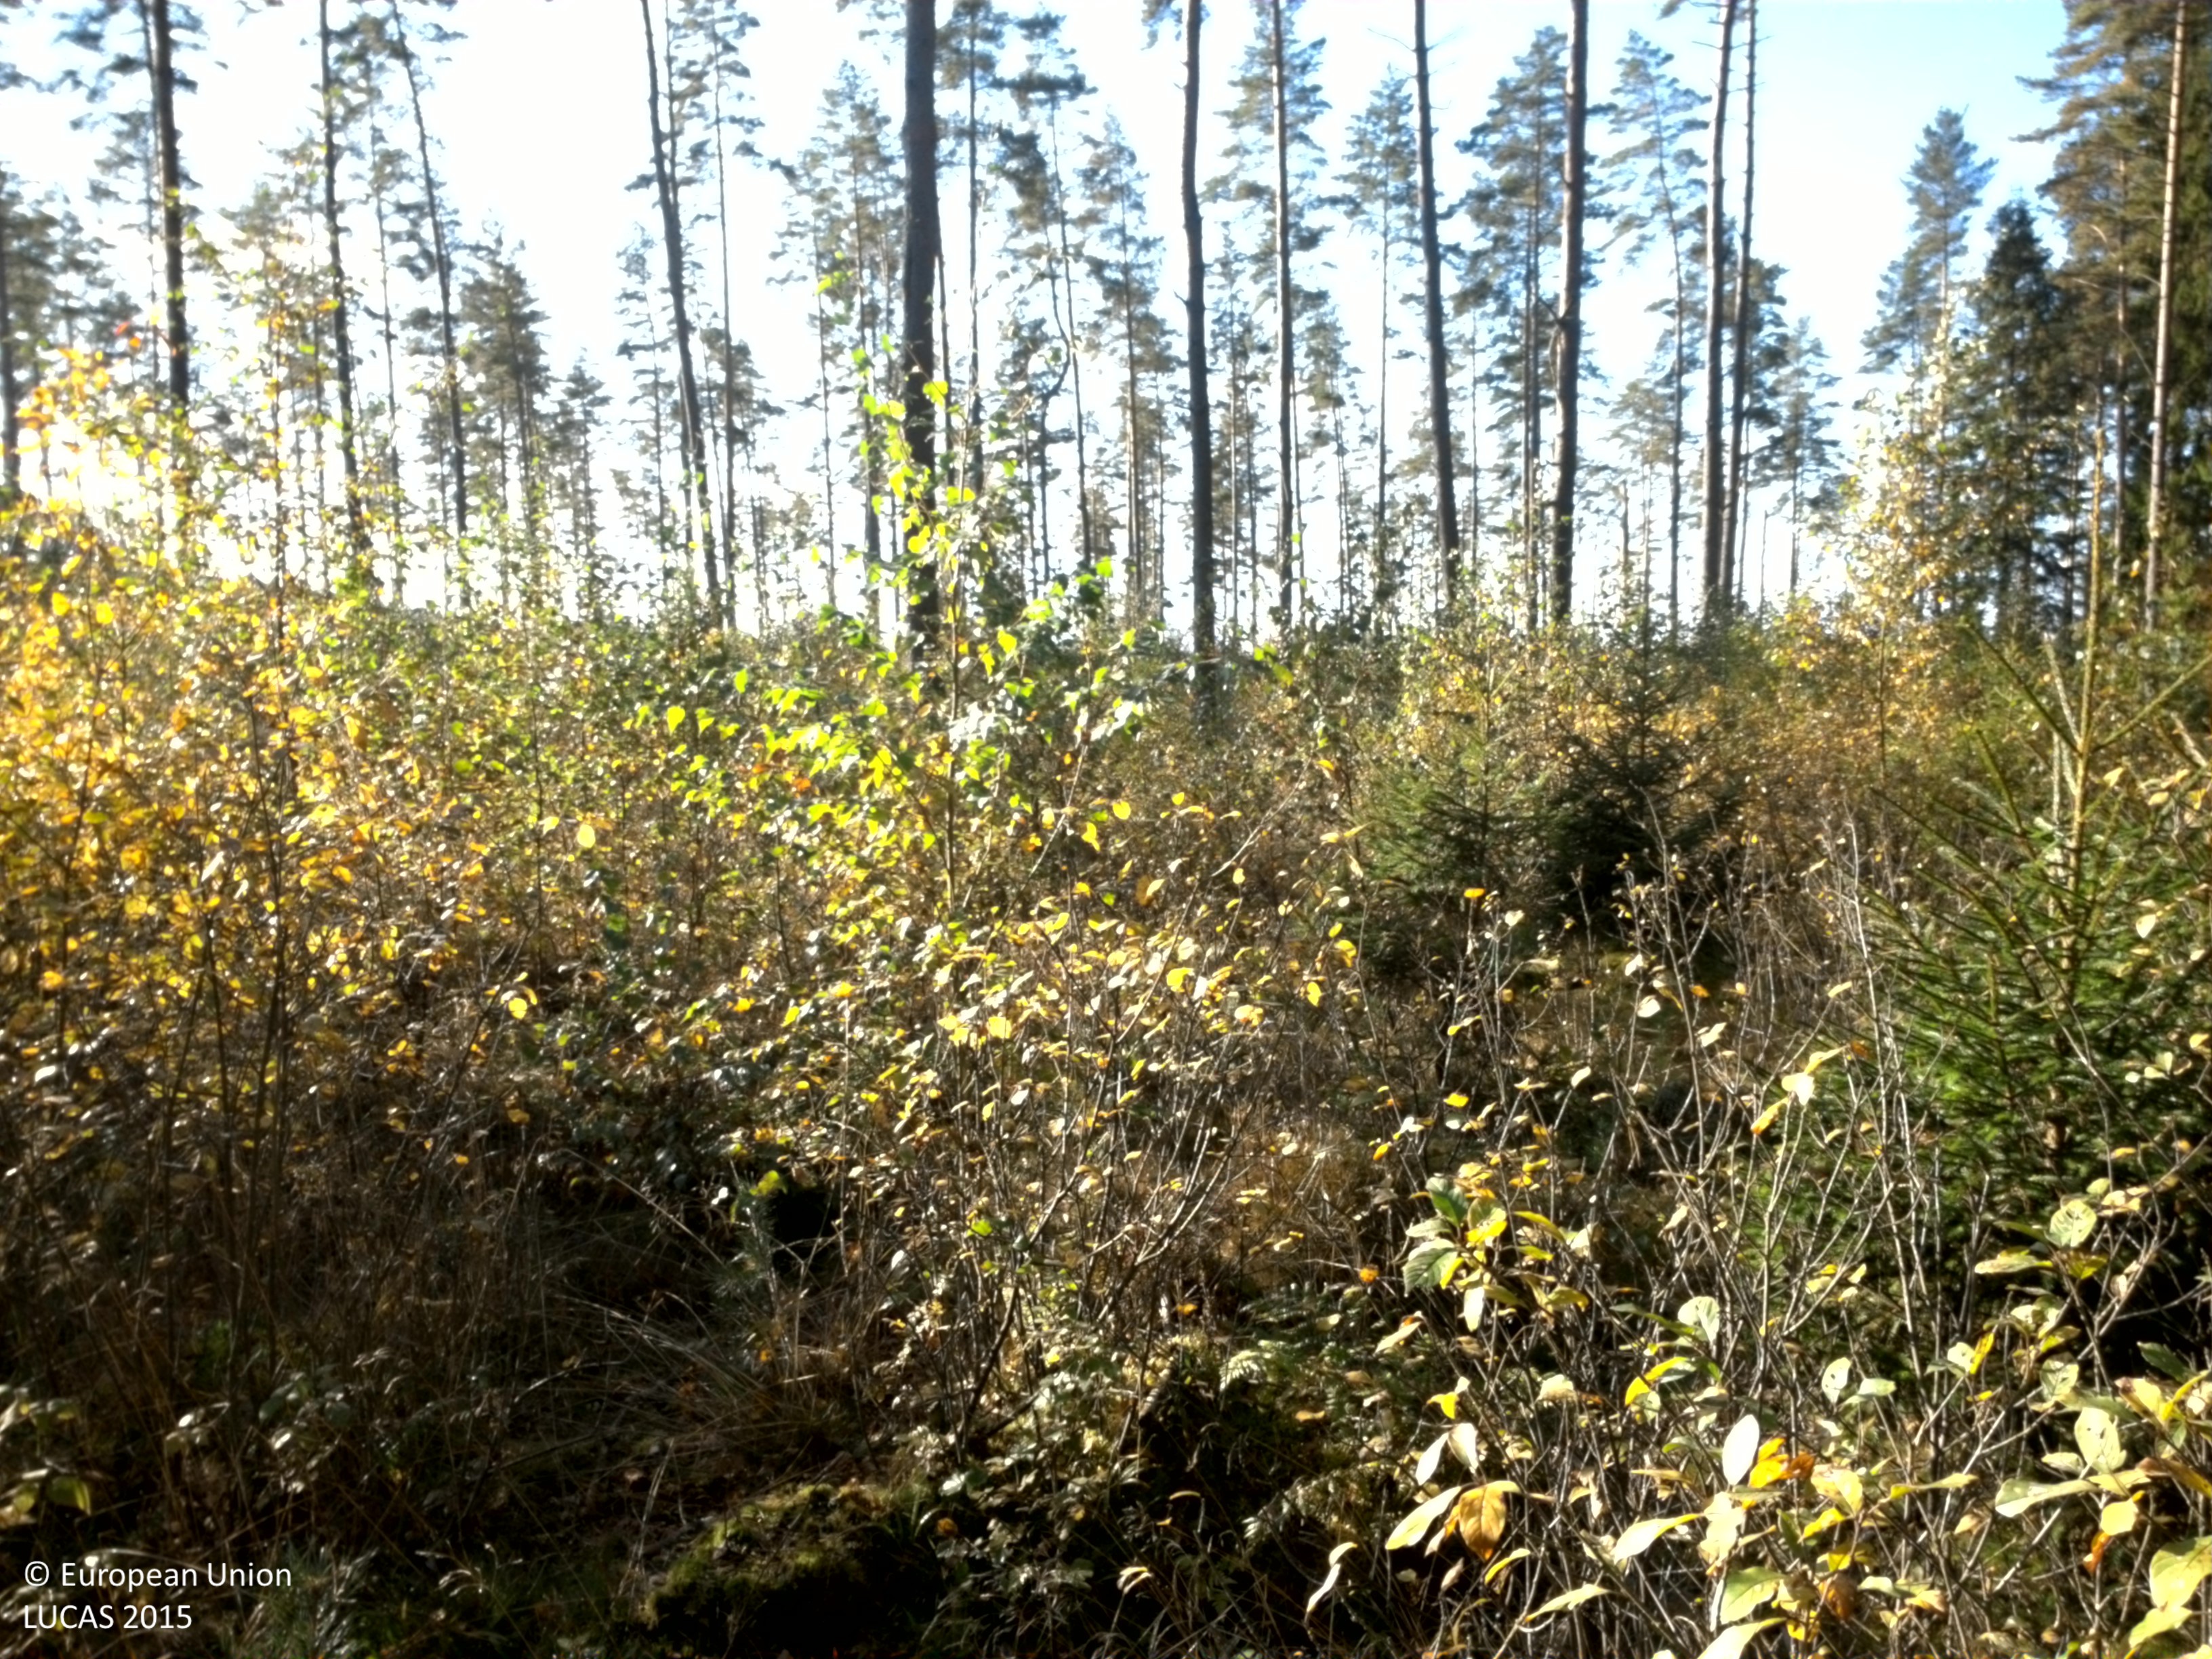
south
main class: Woodland
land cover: Pine dominated mixed woodland
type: boreal forest
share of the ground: 50 - 75 %
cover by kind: herbaceous plants 30 %, coniferous forest trees 25 %, broadleaved forest trees 25 %, shrubs 20 %
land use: Forestry
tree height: < 5 m
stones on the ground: < 10 %
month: October
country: SE
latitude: 58.2047
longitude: 12.9727
